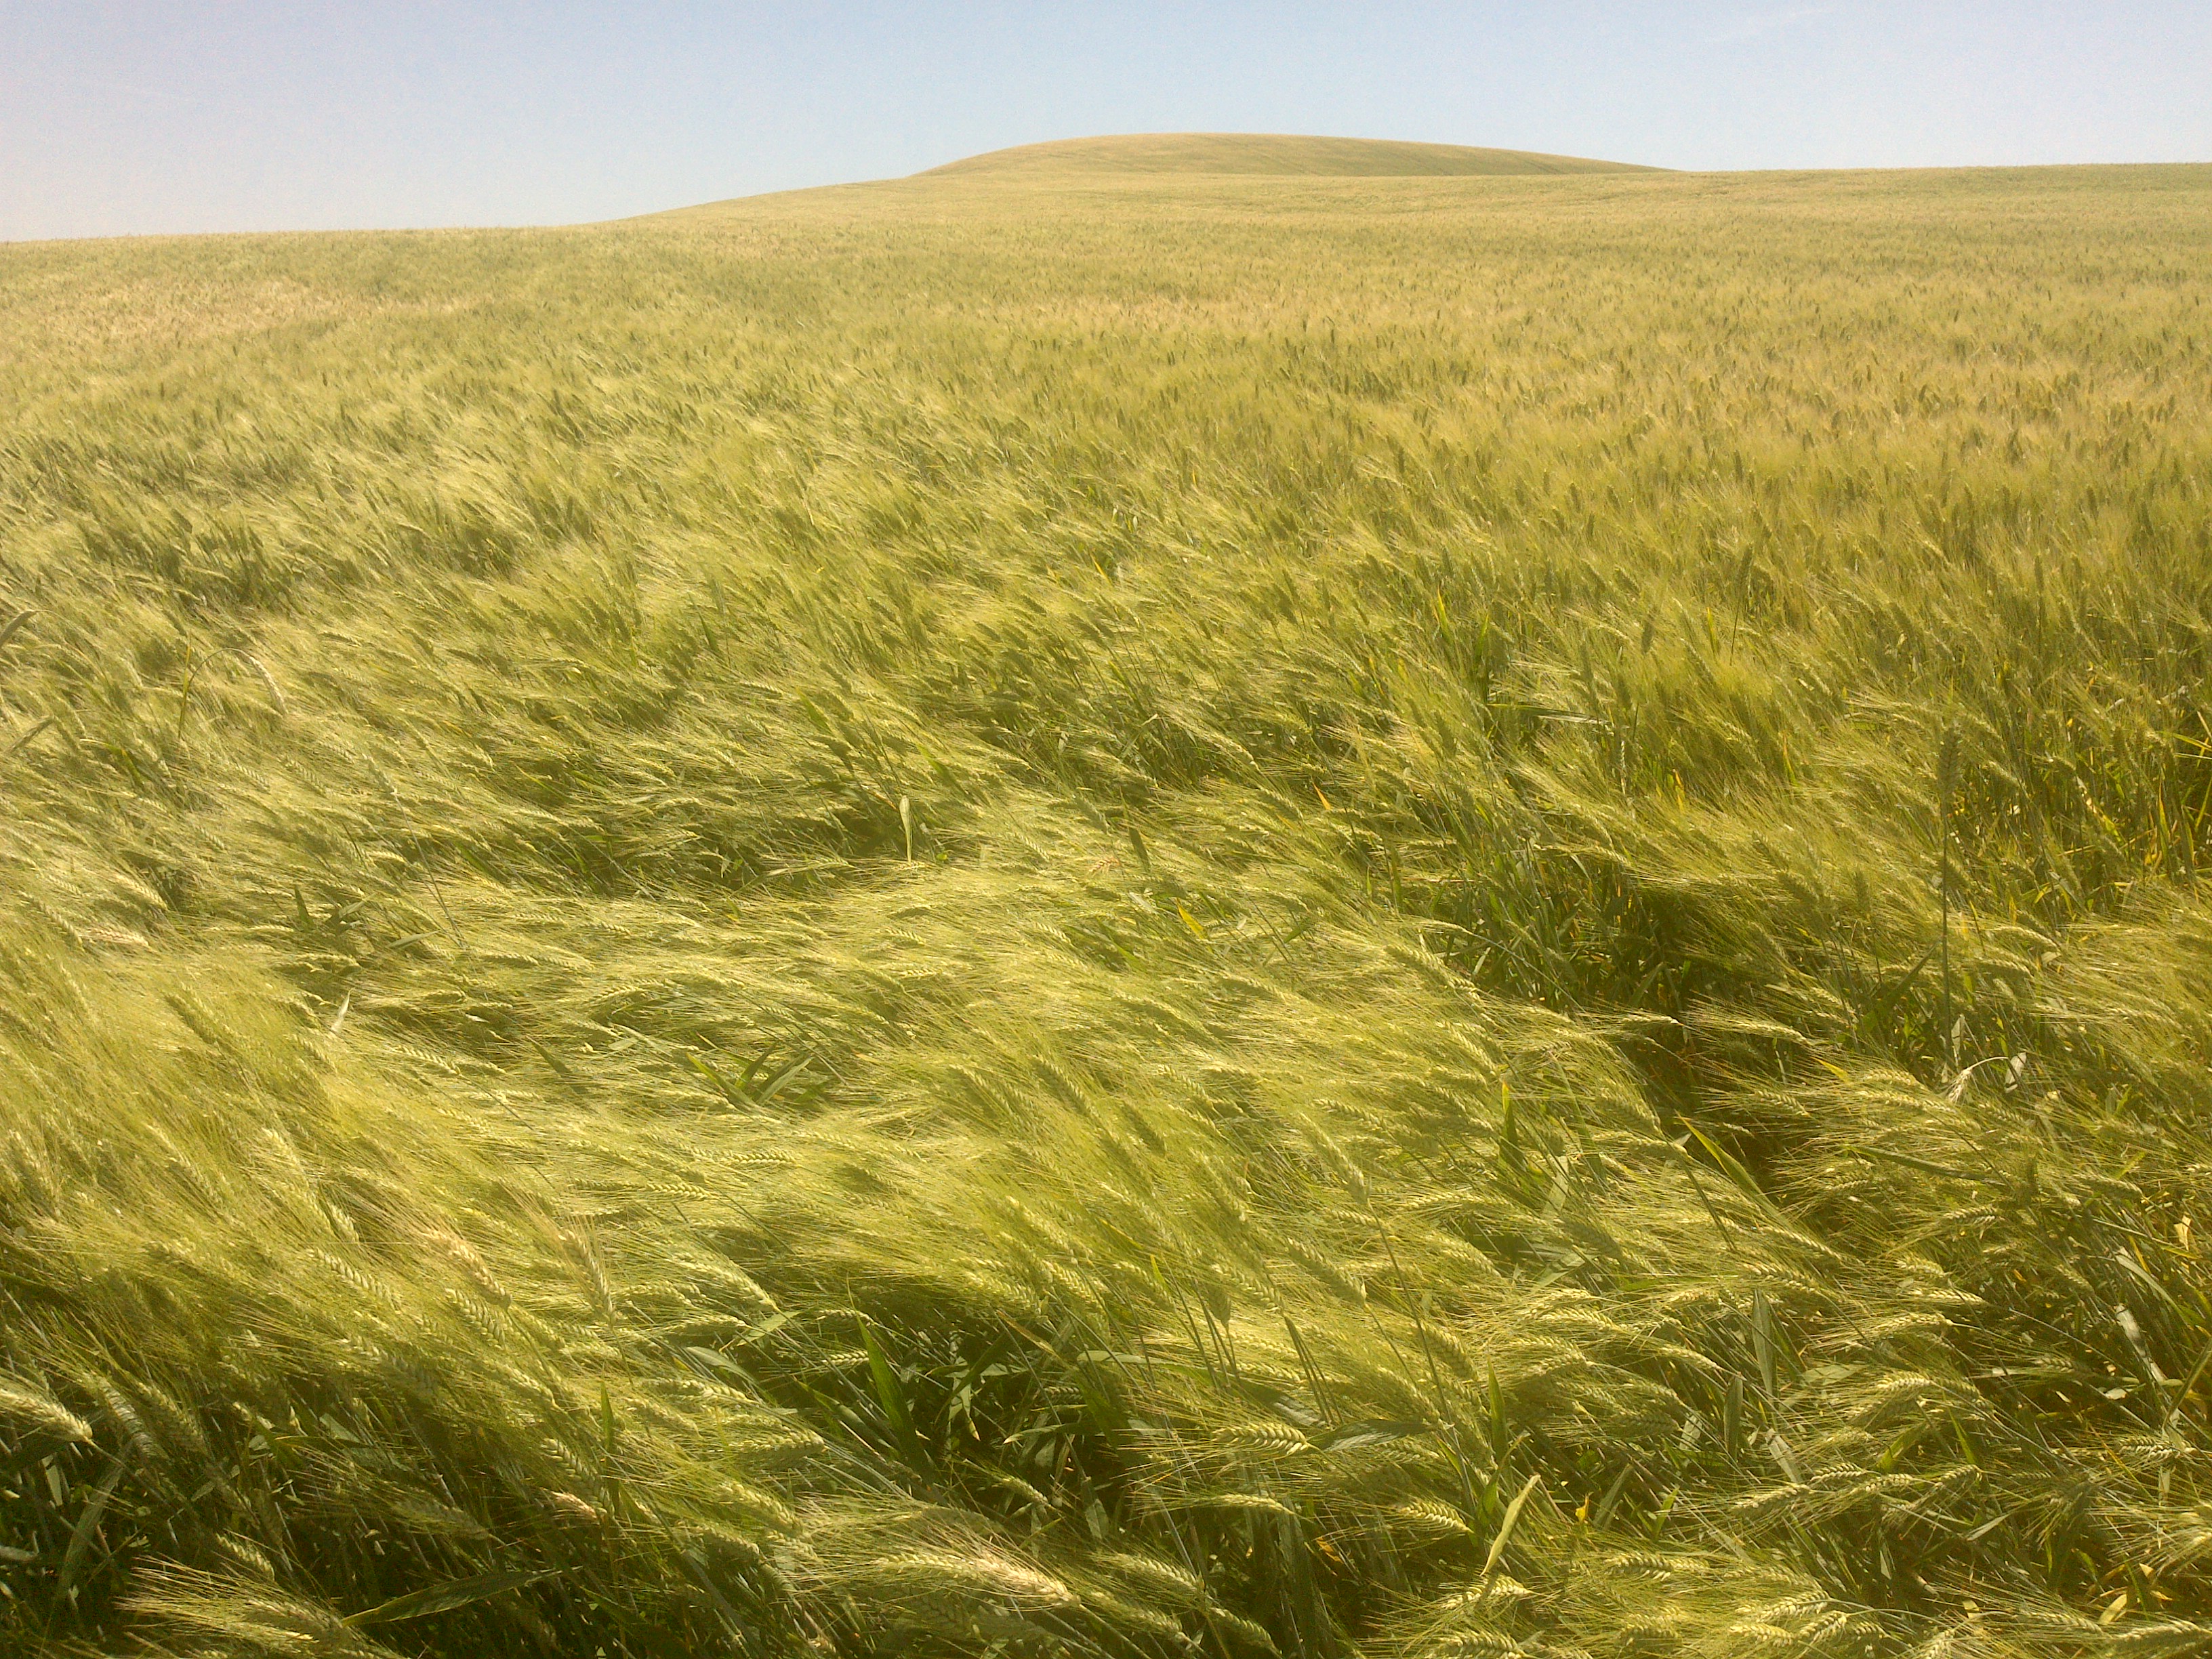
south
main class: Cropland
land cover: Durum wheat
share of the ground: > 75 %
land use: Agriculture (excluding fallow land and kitchen gardens)
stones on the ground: 25 - 50 %
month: May
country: ES
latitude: 37.8331
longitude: -4.5657
